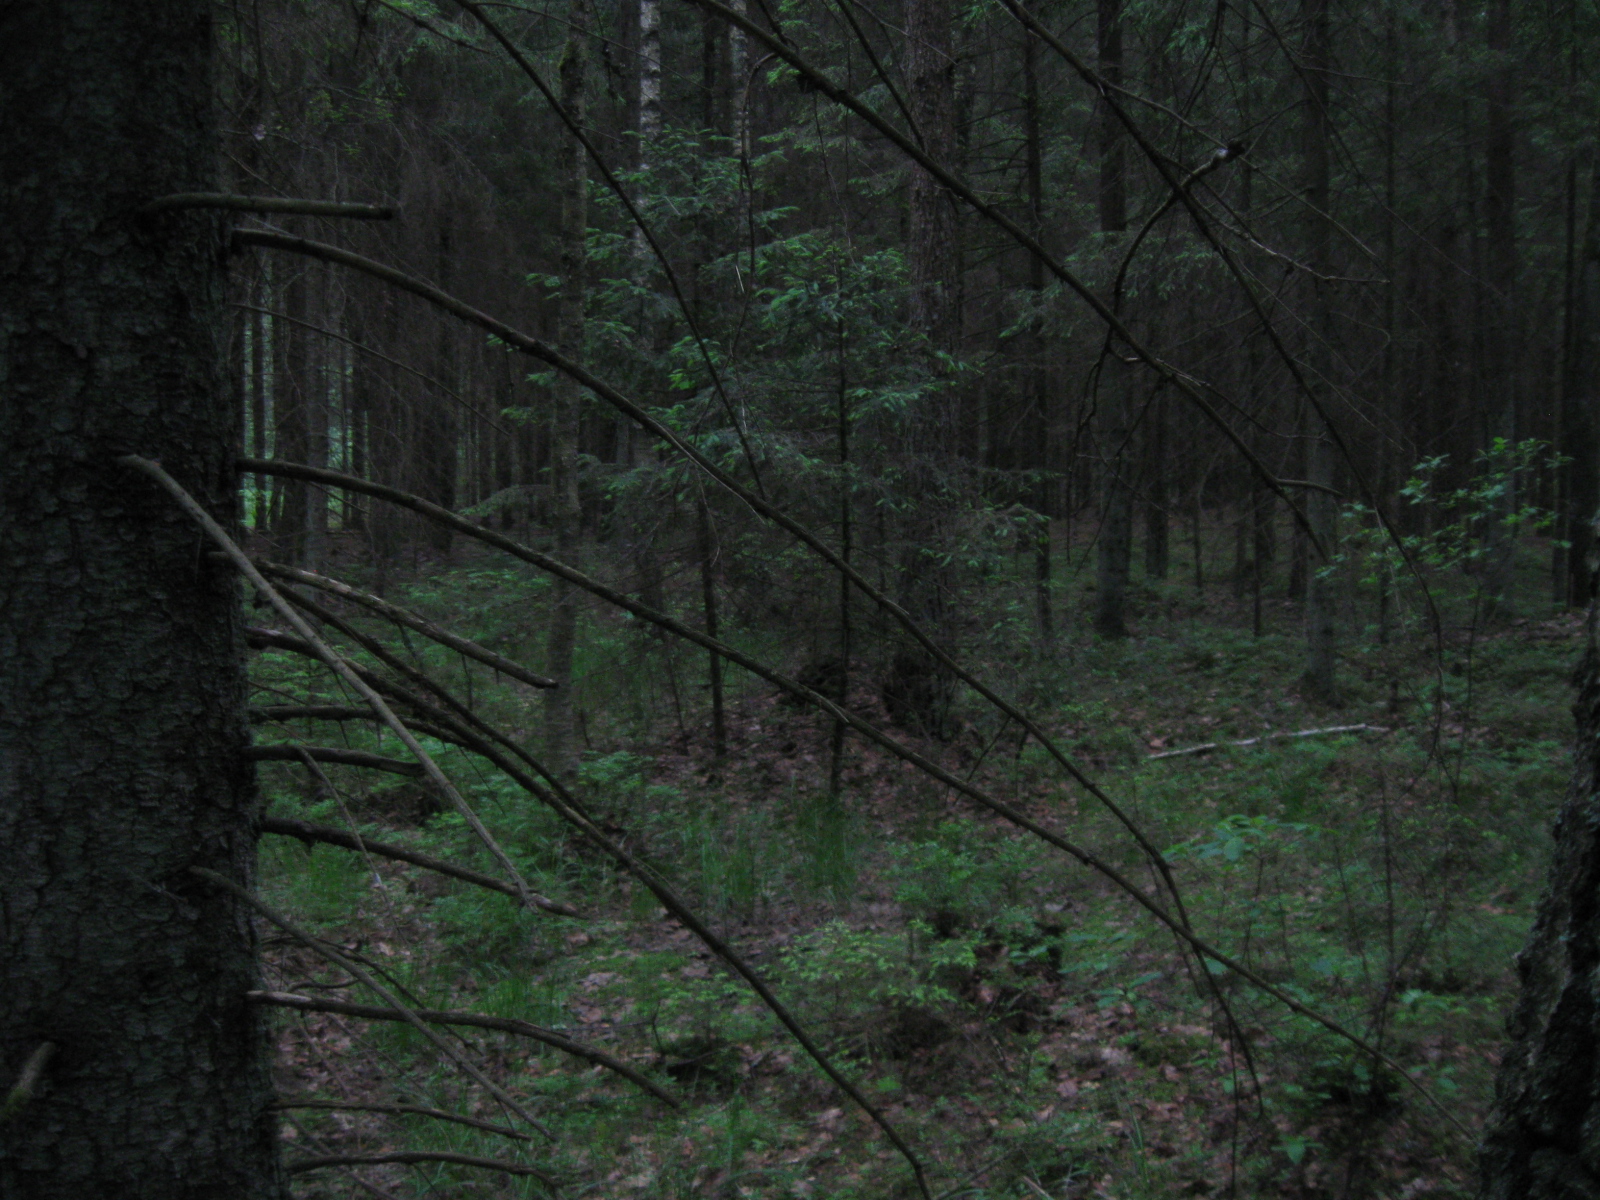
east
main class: Woodland
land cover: Spruce dominated coniferous woodland
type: hemiboreal forest and nemoral coniferous forest and mixed broadleaved-coniferous forest
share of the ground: > 75 %
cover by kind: coniferous forest trees 75 %, broadleaved forest trees 20 %, herbaceous plants 5 %
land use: Forestry
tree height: > 5 m
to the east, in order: Spruce dominated coniferous woodland; Tracks; Spruce dominated coniferous woodland
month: June
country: LT
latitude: 55.0166
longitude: 24.6018
